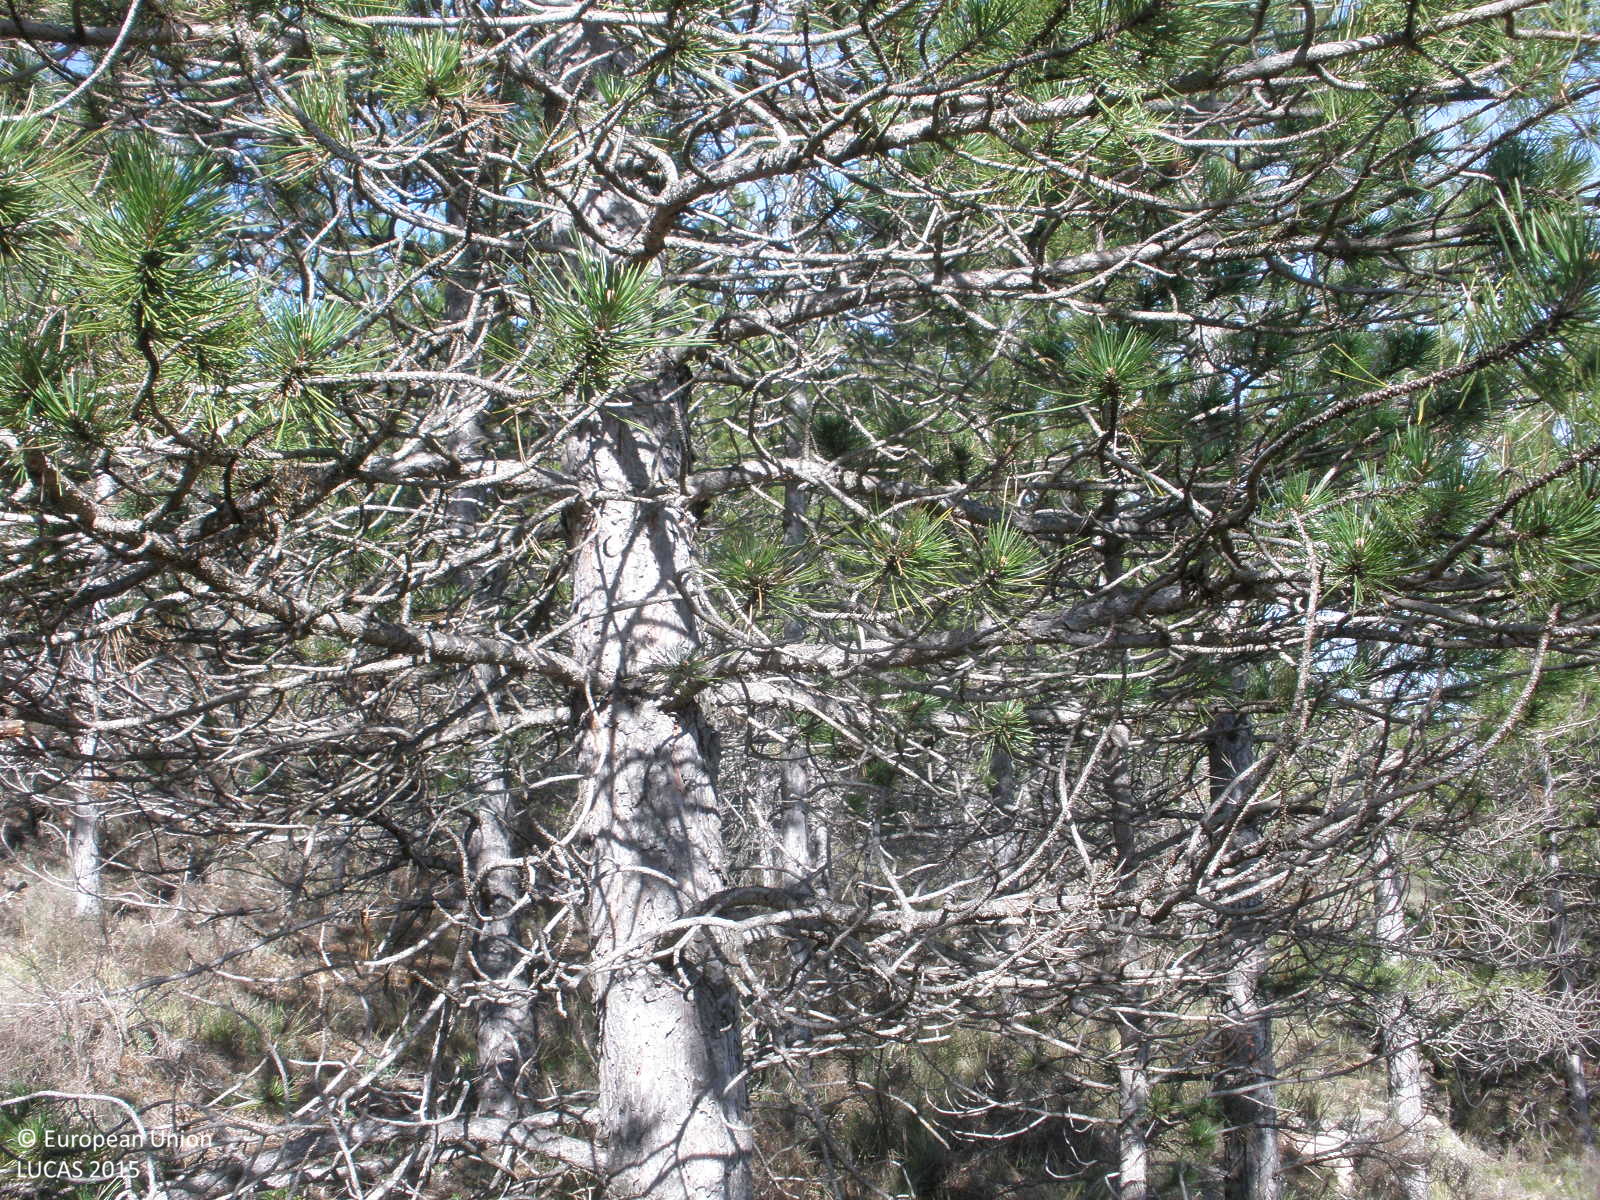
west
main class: Woodland
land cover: Pine dominated coniferous woodland
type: coniferous forest of the mediterranean region
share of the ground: 25 - 50 %
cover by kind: coniferous forest trees 40 %, shrubs 40 %, herbaceous plants 20 %
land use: Semi-natural and natural areas not in use
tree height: > 5 m
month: April
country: ES
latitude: 40.0819
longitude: -1.1845
